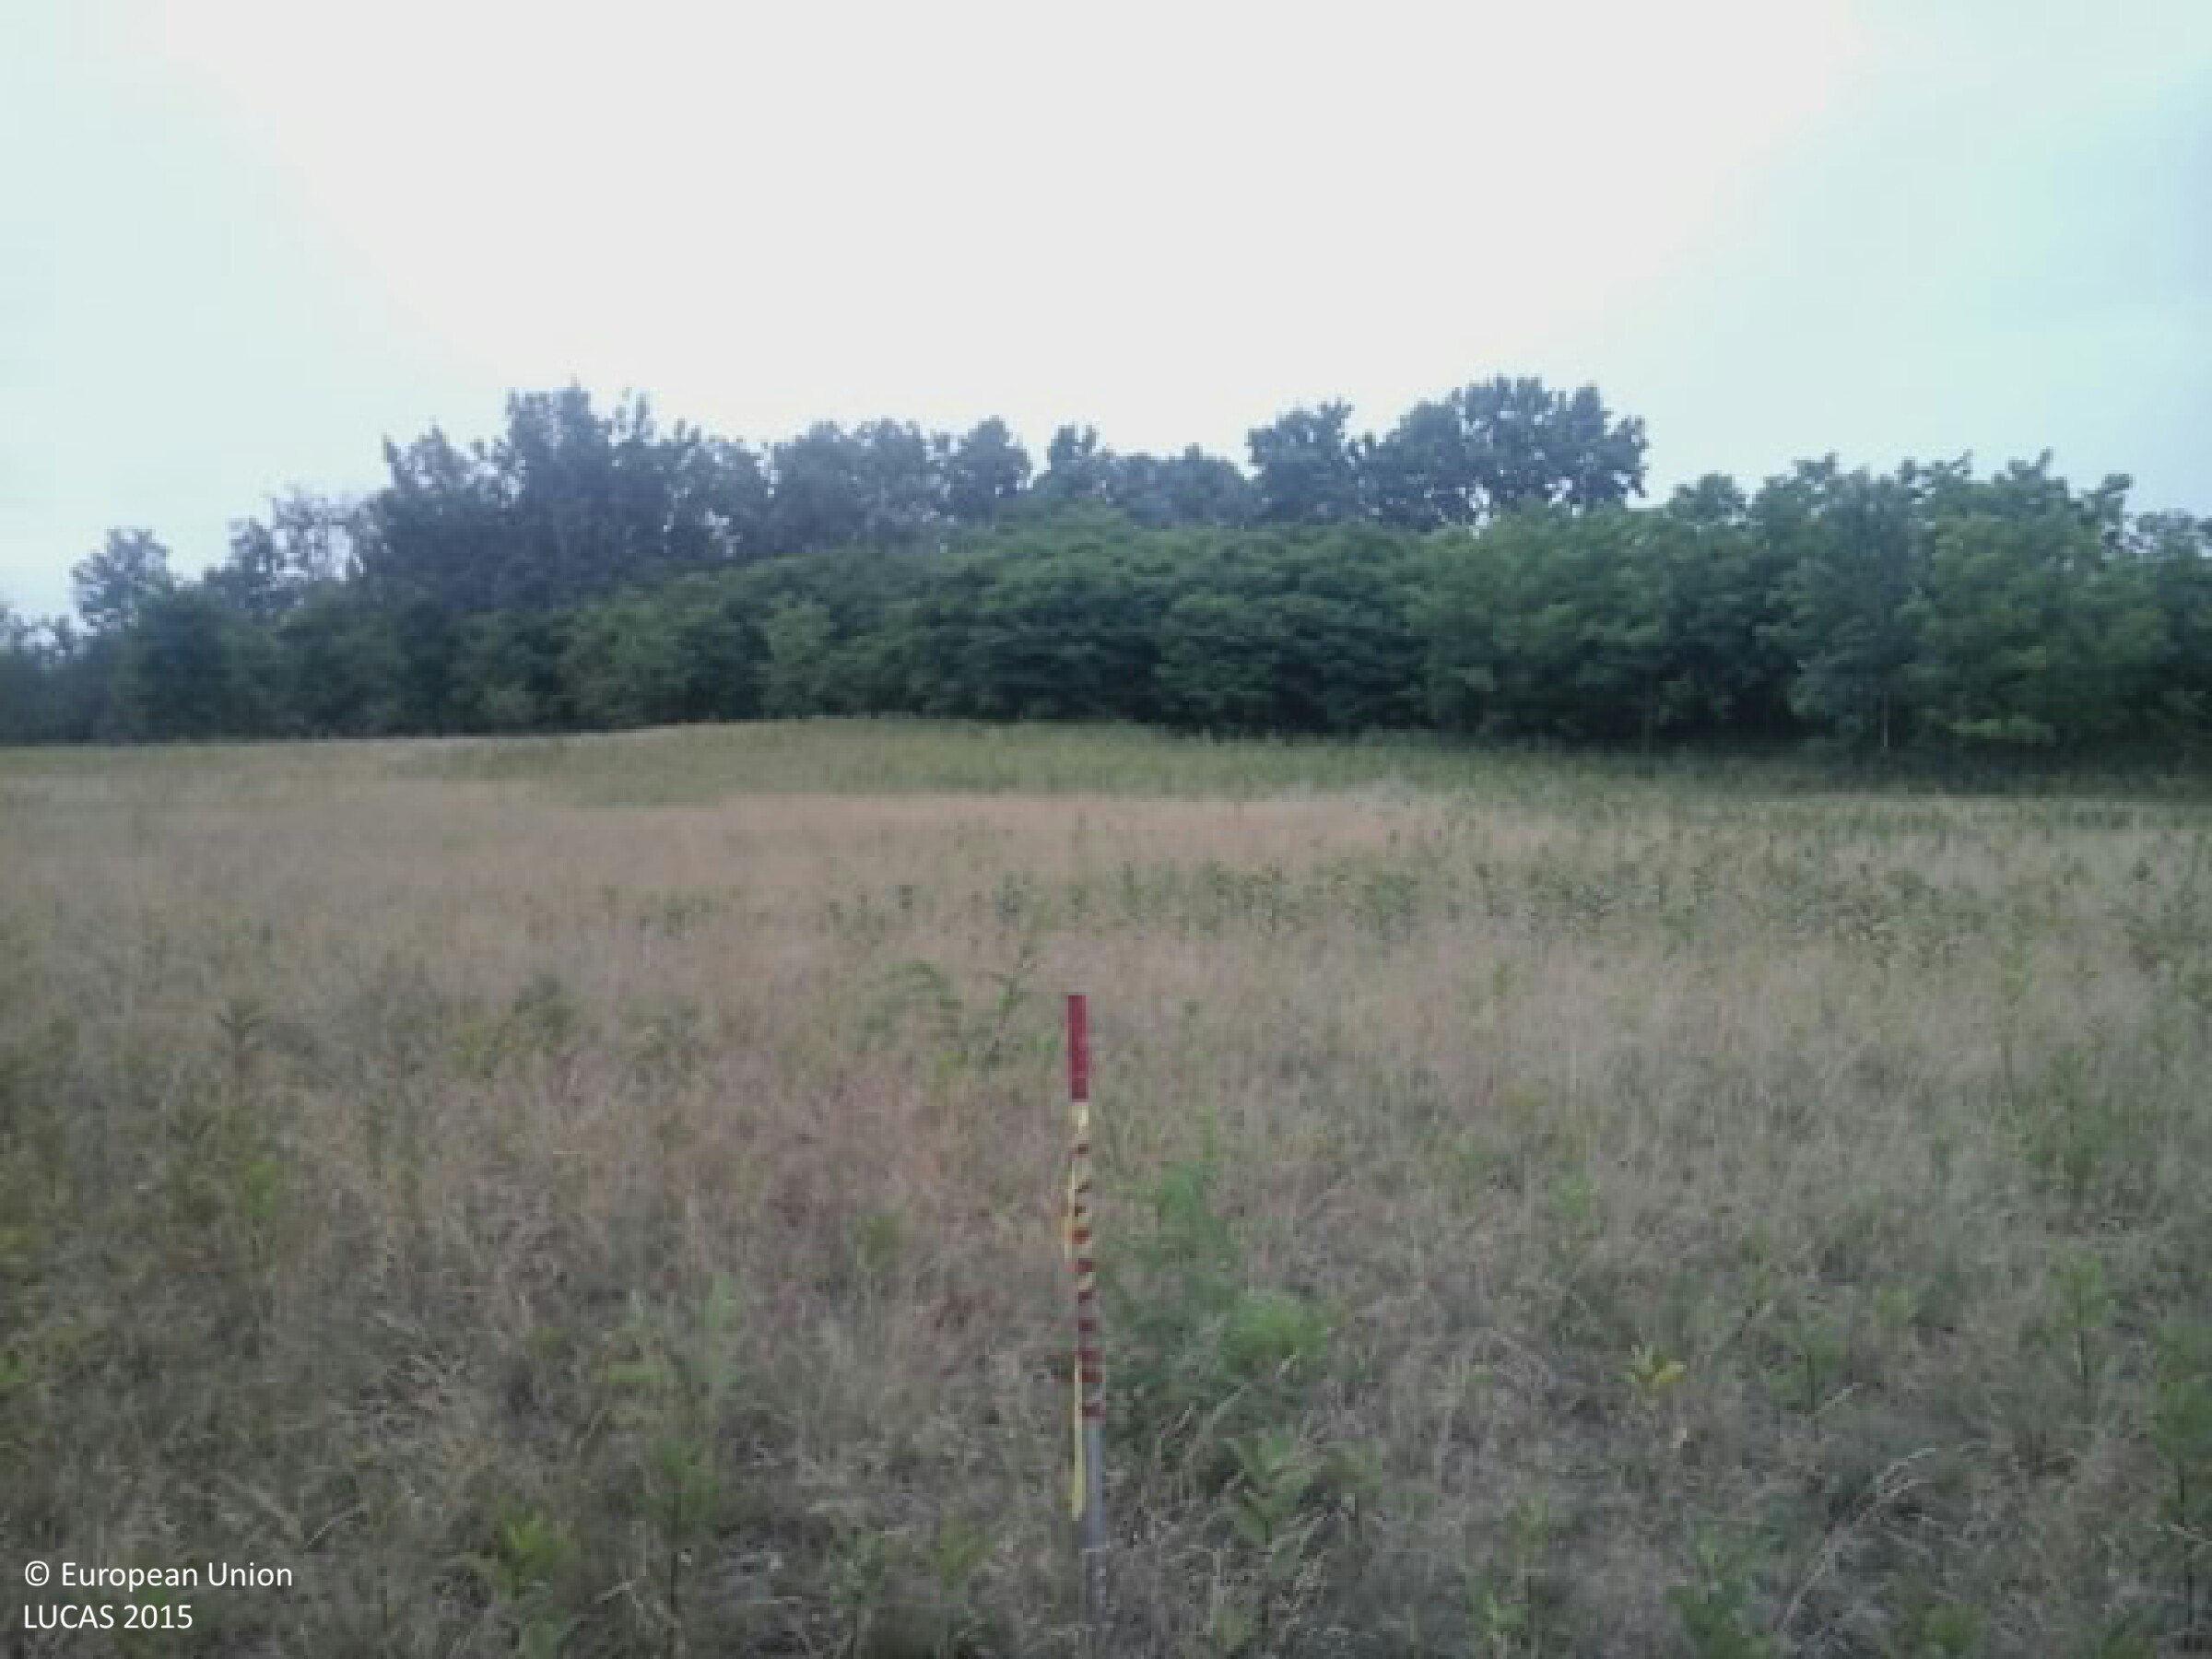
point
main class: Grassland
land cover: Grassland without tree/shrub cover
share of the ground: > 75 %
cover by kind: herbaceous plants 100 %
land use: Abandoned areas
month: June
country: HU
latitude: 46.7667
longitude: 19.6441
